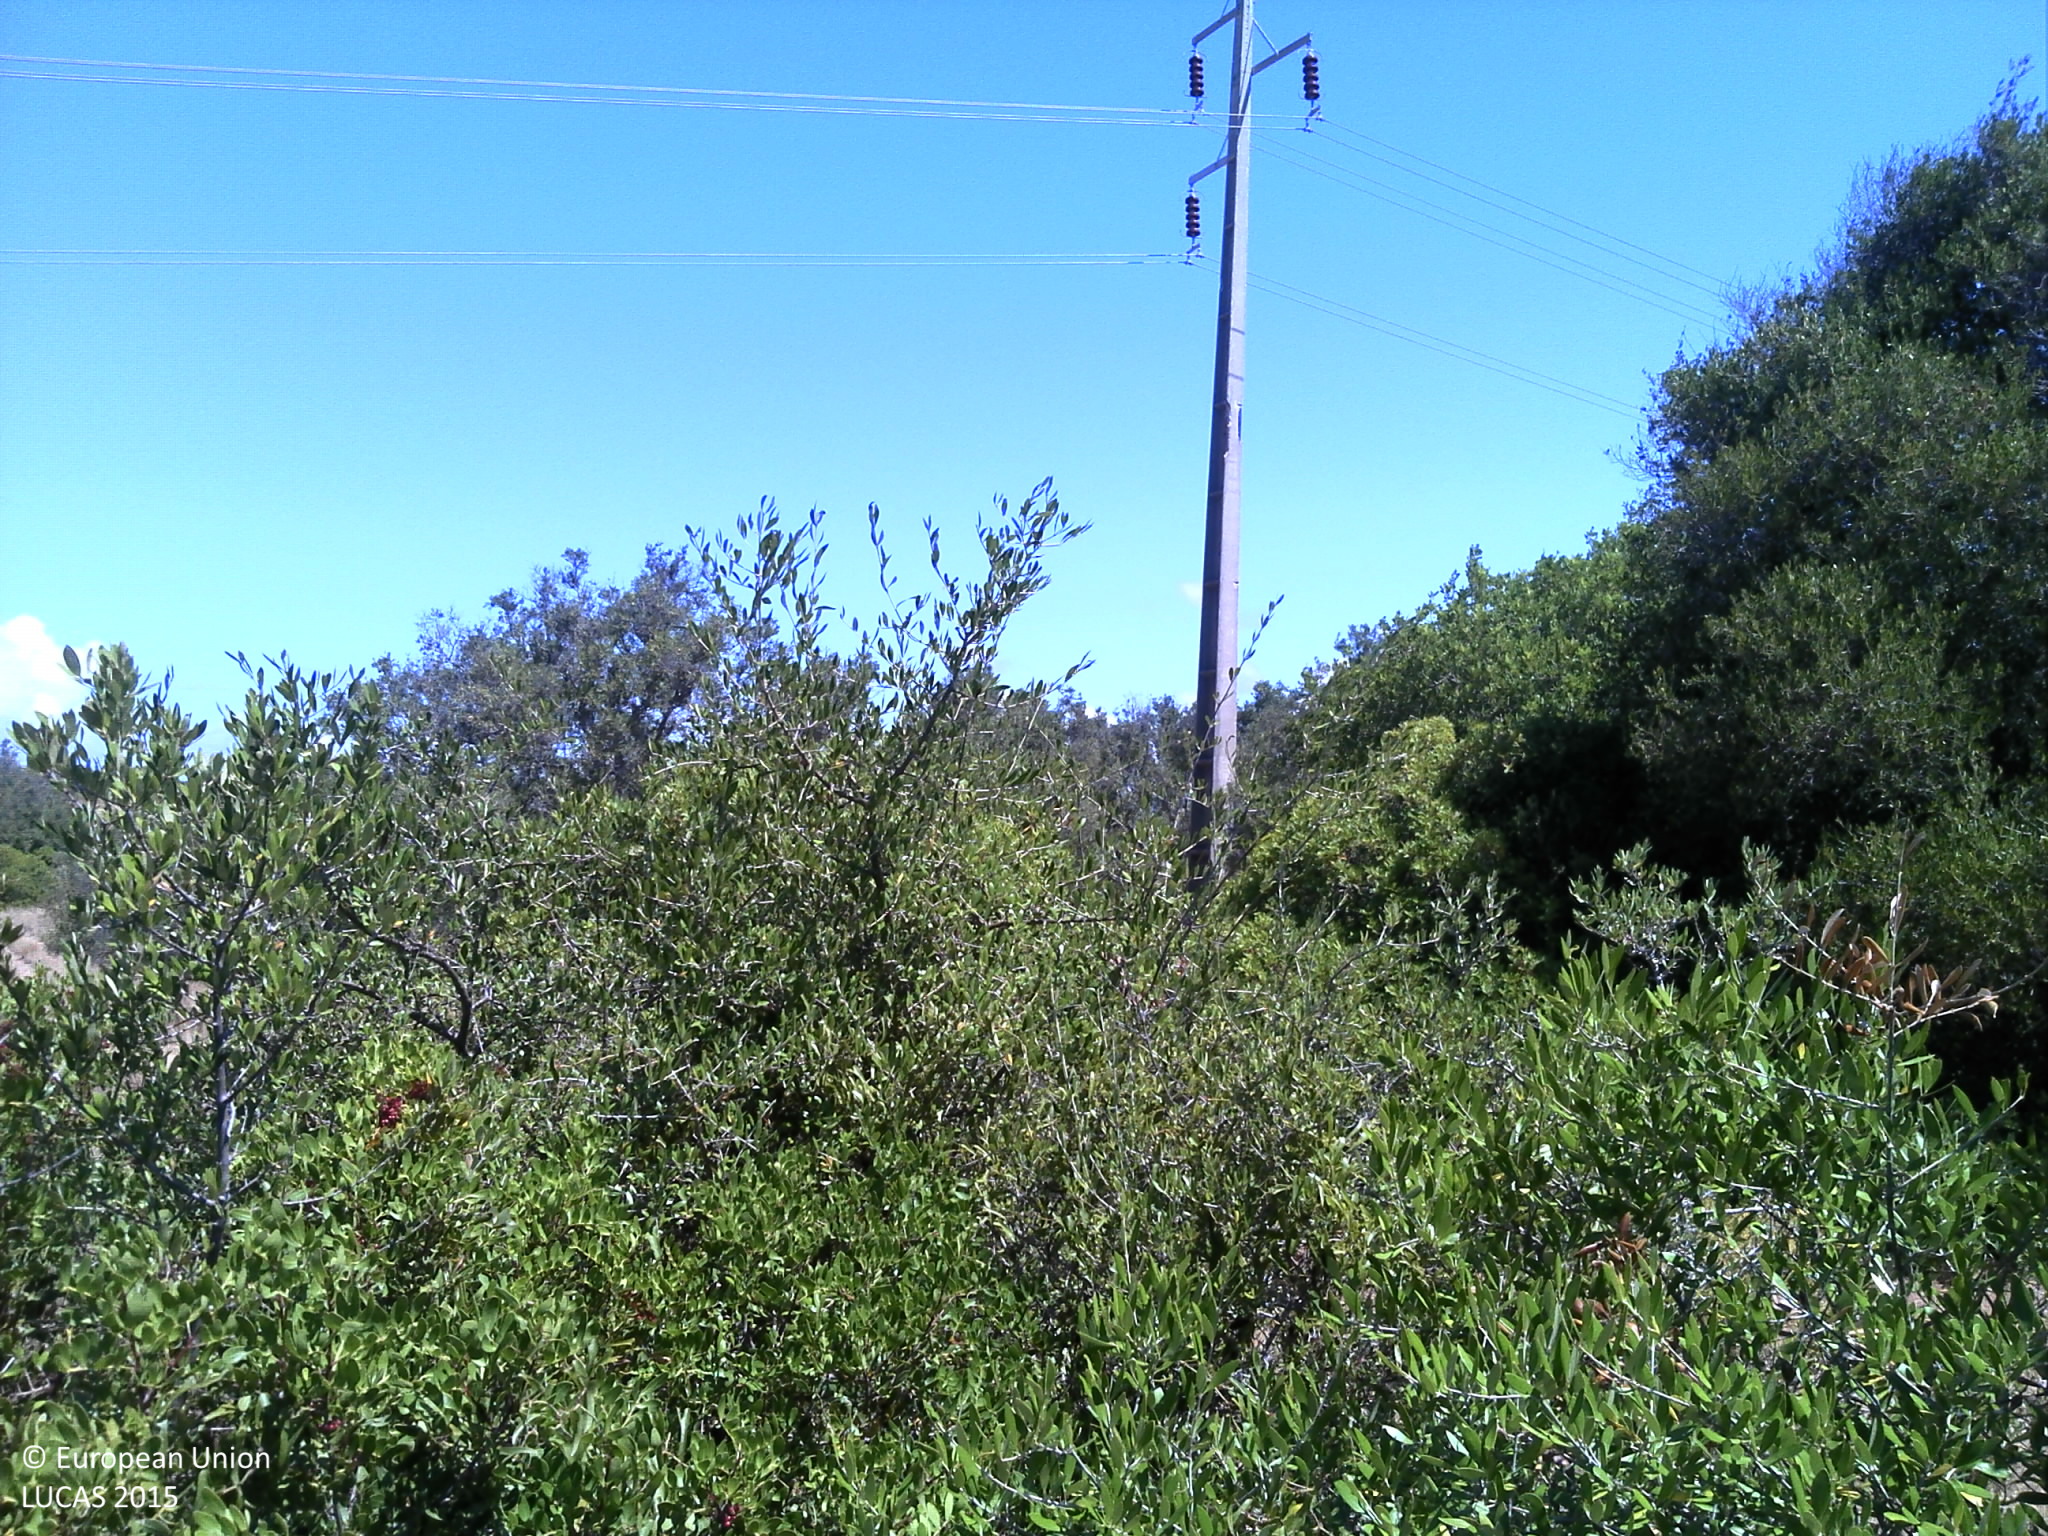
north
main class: Cropland
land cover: Olive groves
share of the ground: 25 - 50 %
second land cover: Grassland without tree/shrub cover
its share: 25 - 50 %
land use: Abandoned areas
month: July
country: PT
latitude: 37.1611
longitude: -8.6658
